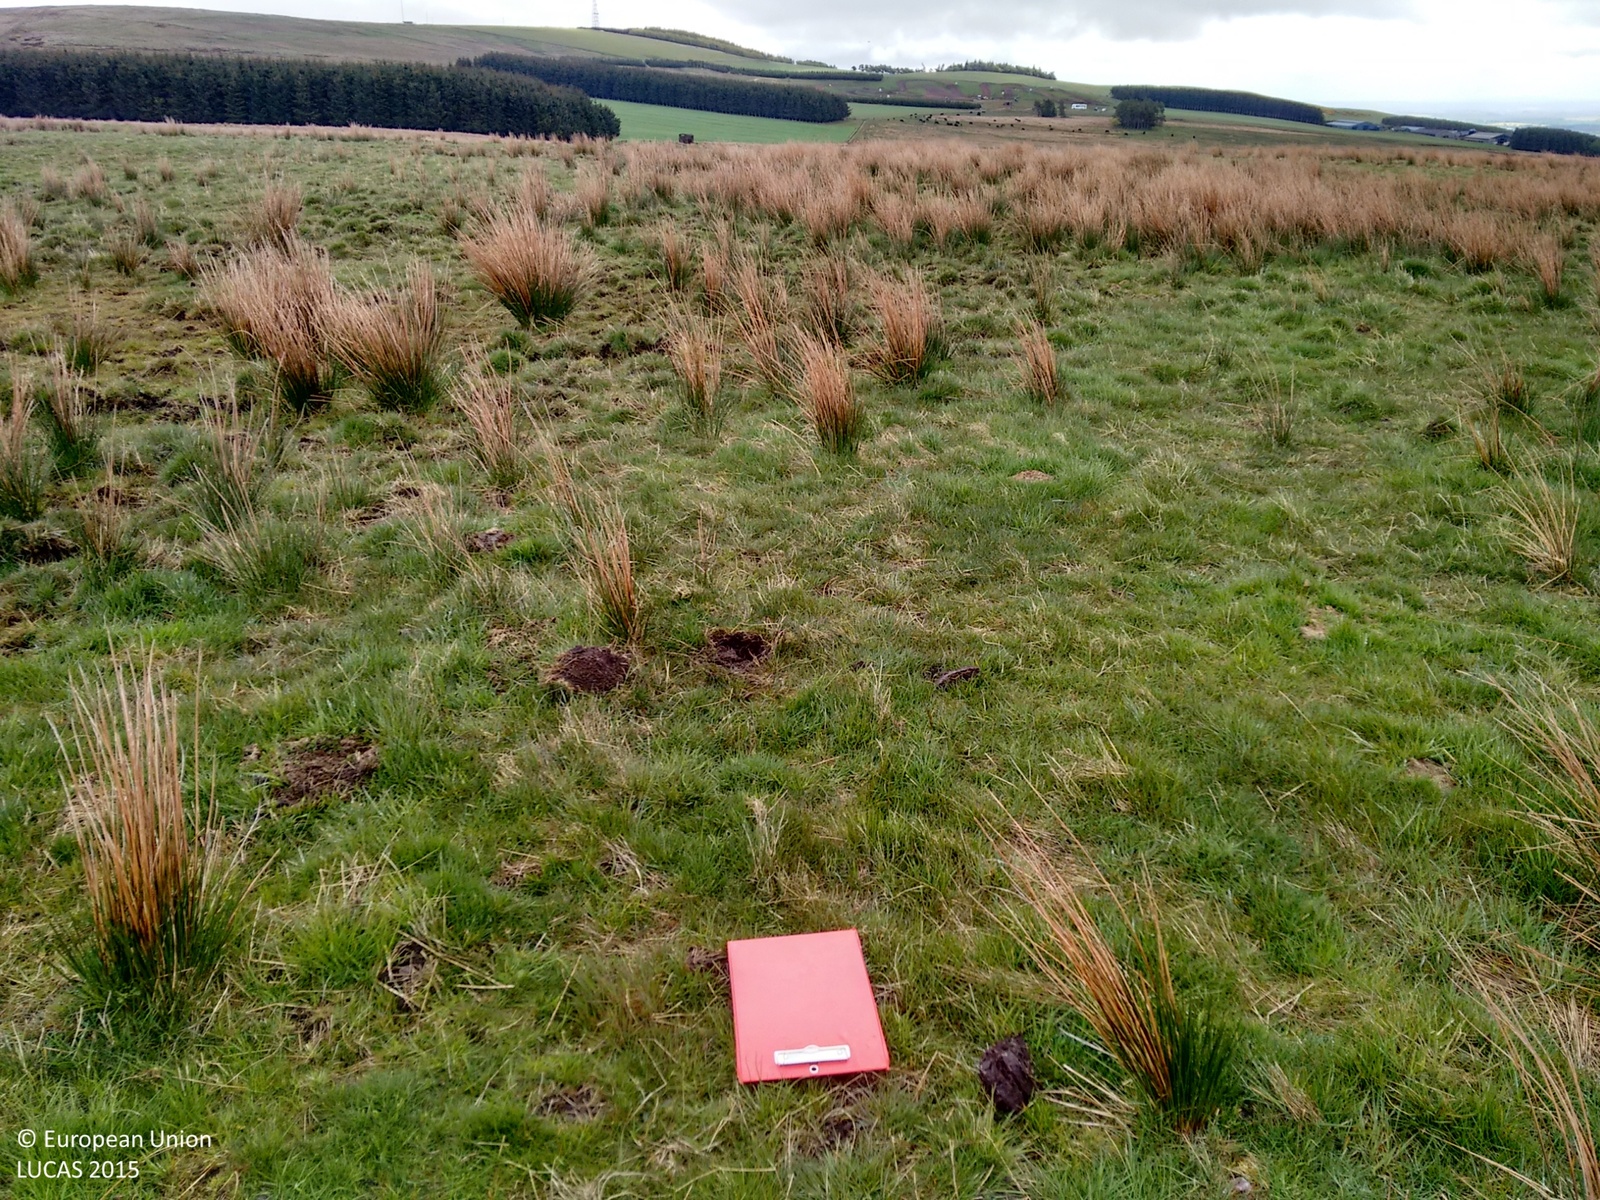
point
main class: Grassland
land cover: Grassland without tree/shrub cover
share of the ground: > 75 %
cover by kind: herbaceous plants 100 %
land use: Agriculture (excluding fallow land and kitchen gardens)
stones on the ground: < 10 %
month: May
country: GB
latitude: 55.7791
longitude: -2.4475
